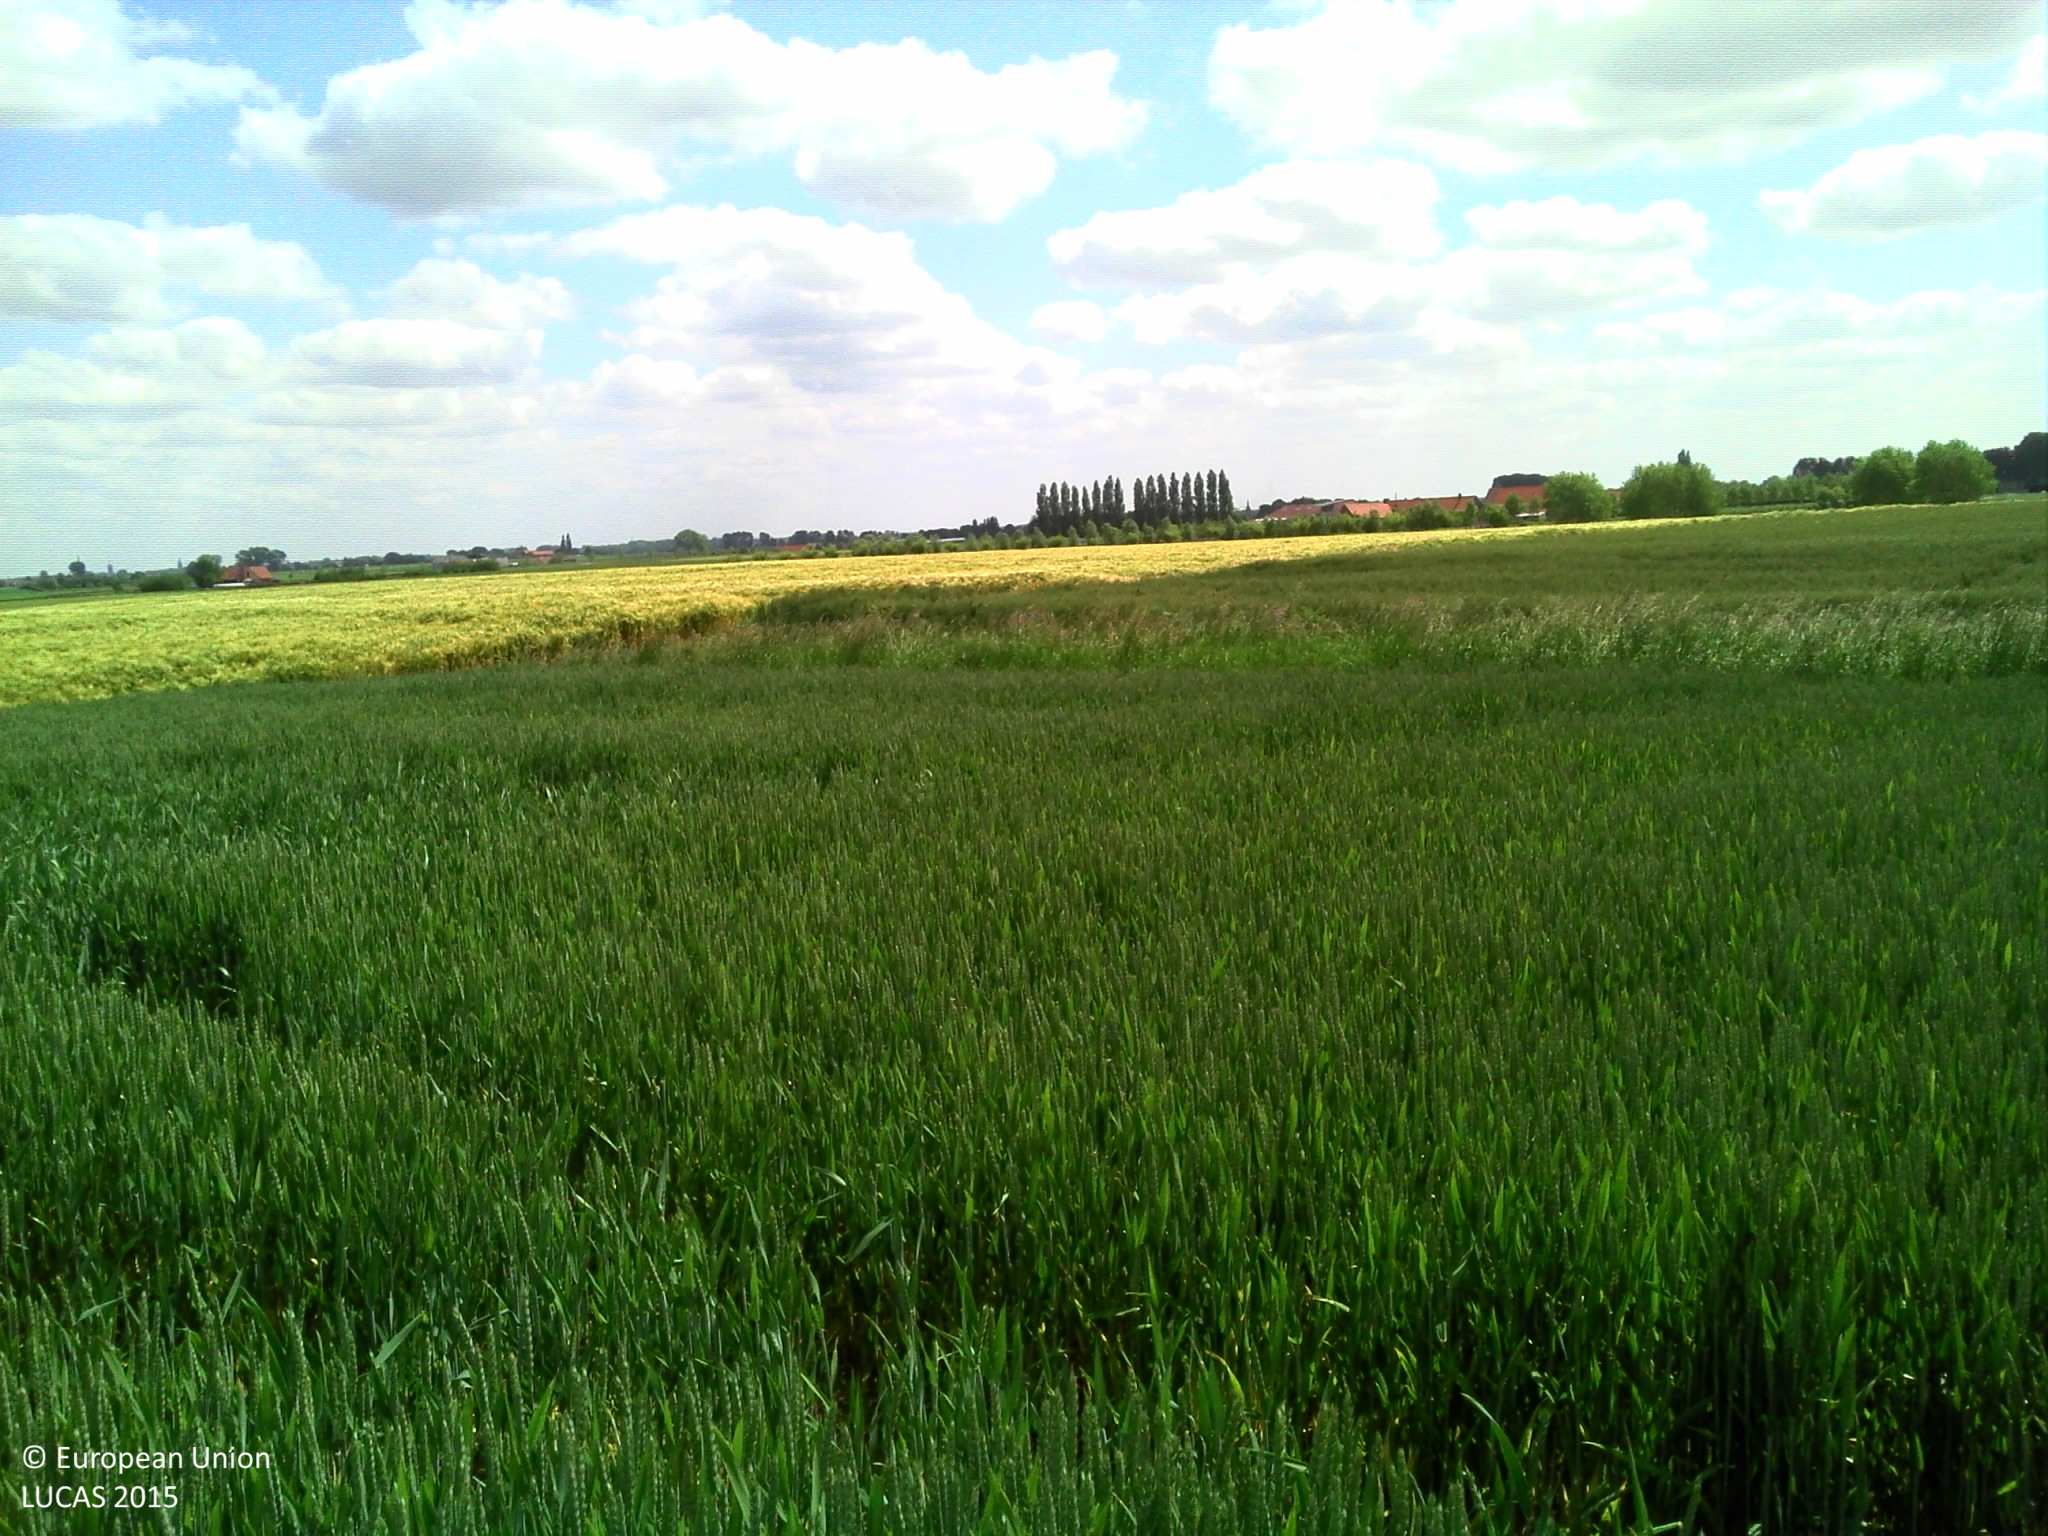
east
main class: Cropland
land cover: Common wheat
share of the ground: > 75 %
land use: Agriculture (excluding fallow land and kitchen gardens)
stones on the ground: < 10 %
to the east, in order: Common wheat; Spontaneously vegetated surfaces; Barley; Grass margins; Ditches and canals; Grass margins; Paved roads, cycling and walking lanes; Grass margins
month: June
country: BE
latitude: 50.8225
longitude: 2.7917
